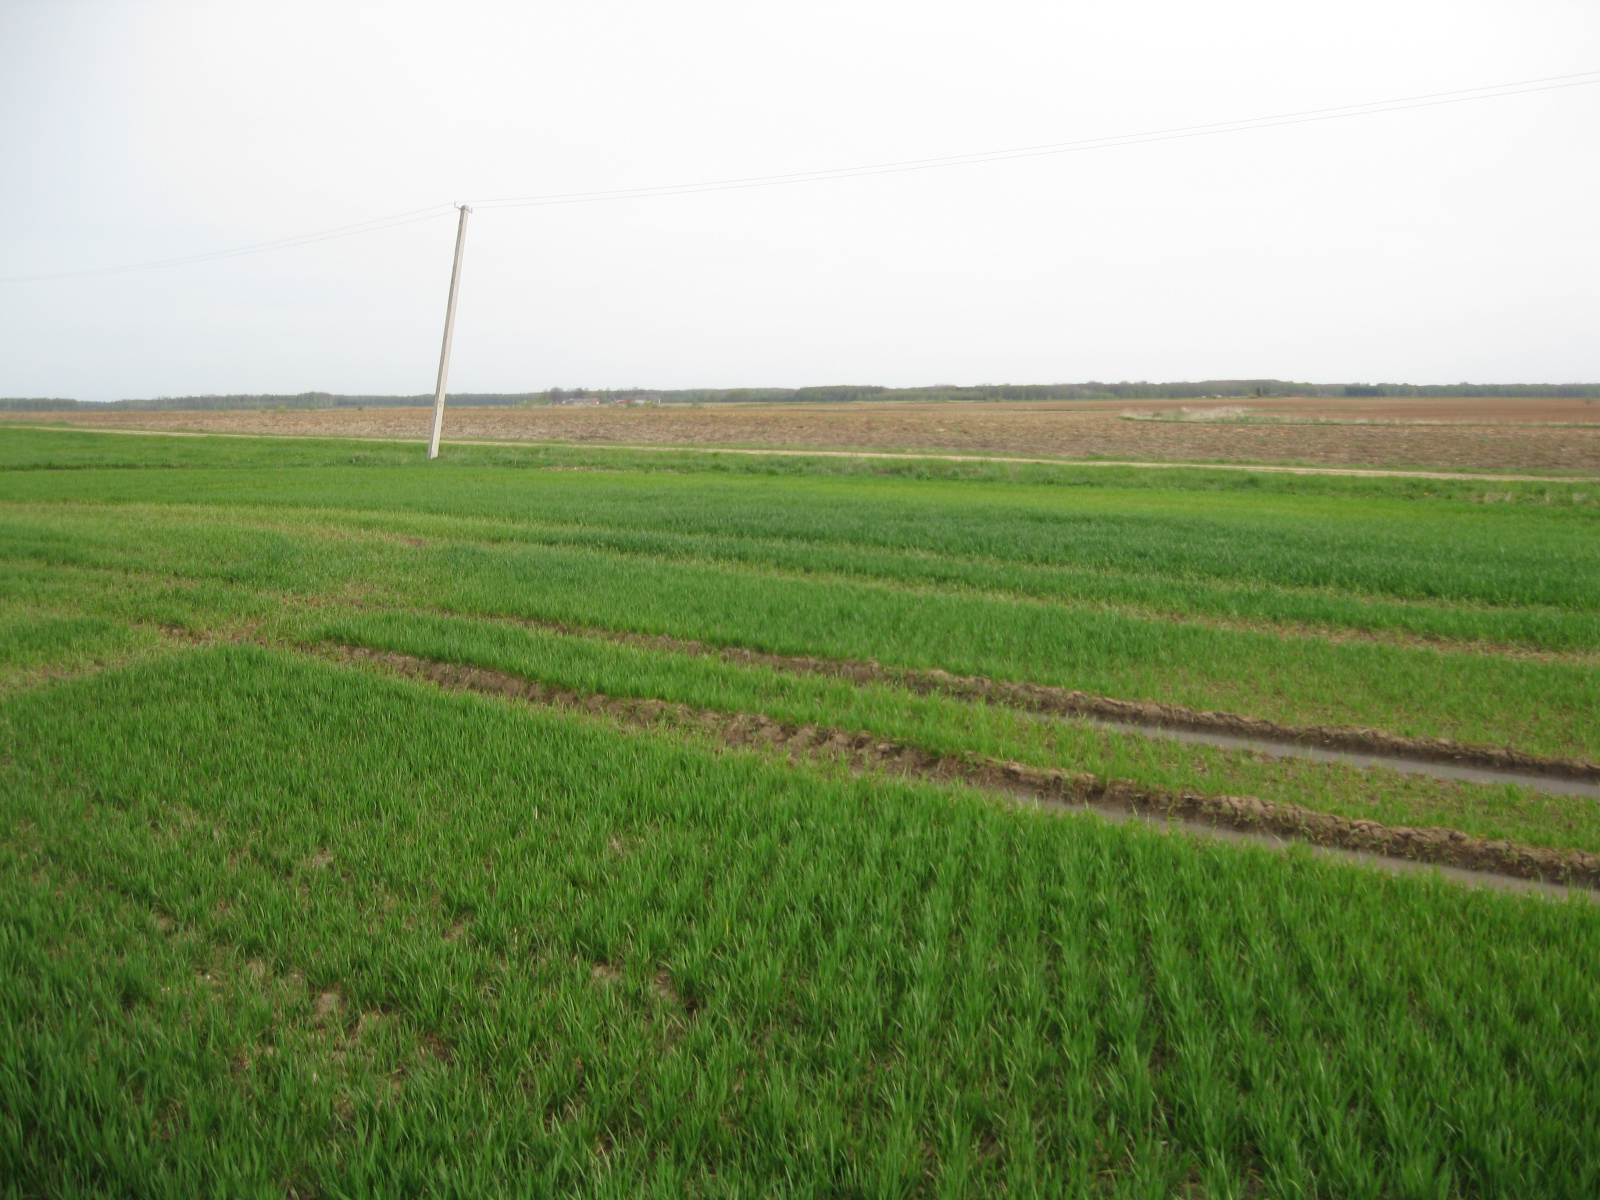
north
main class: Cropland
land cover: Common wheat
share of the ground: > 75 %
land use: Agriculture (excluding fallow land and kitchen gardens)
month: May
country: LT
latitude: 56.2572
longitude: 24.4793
